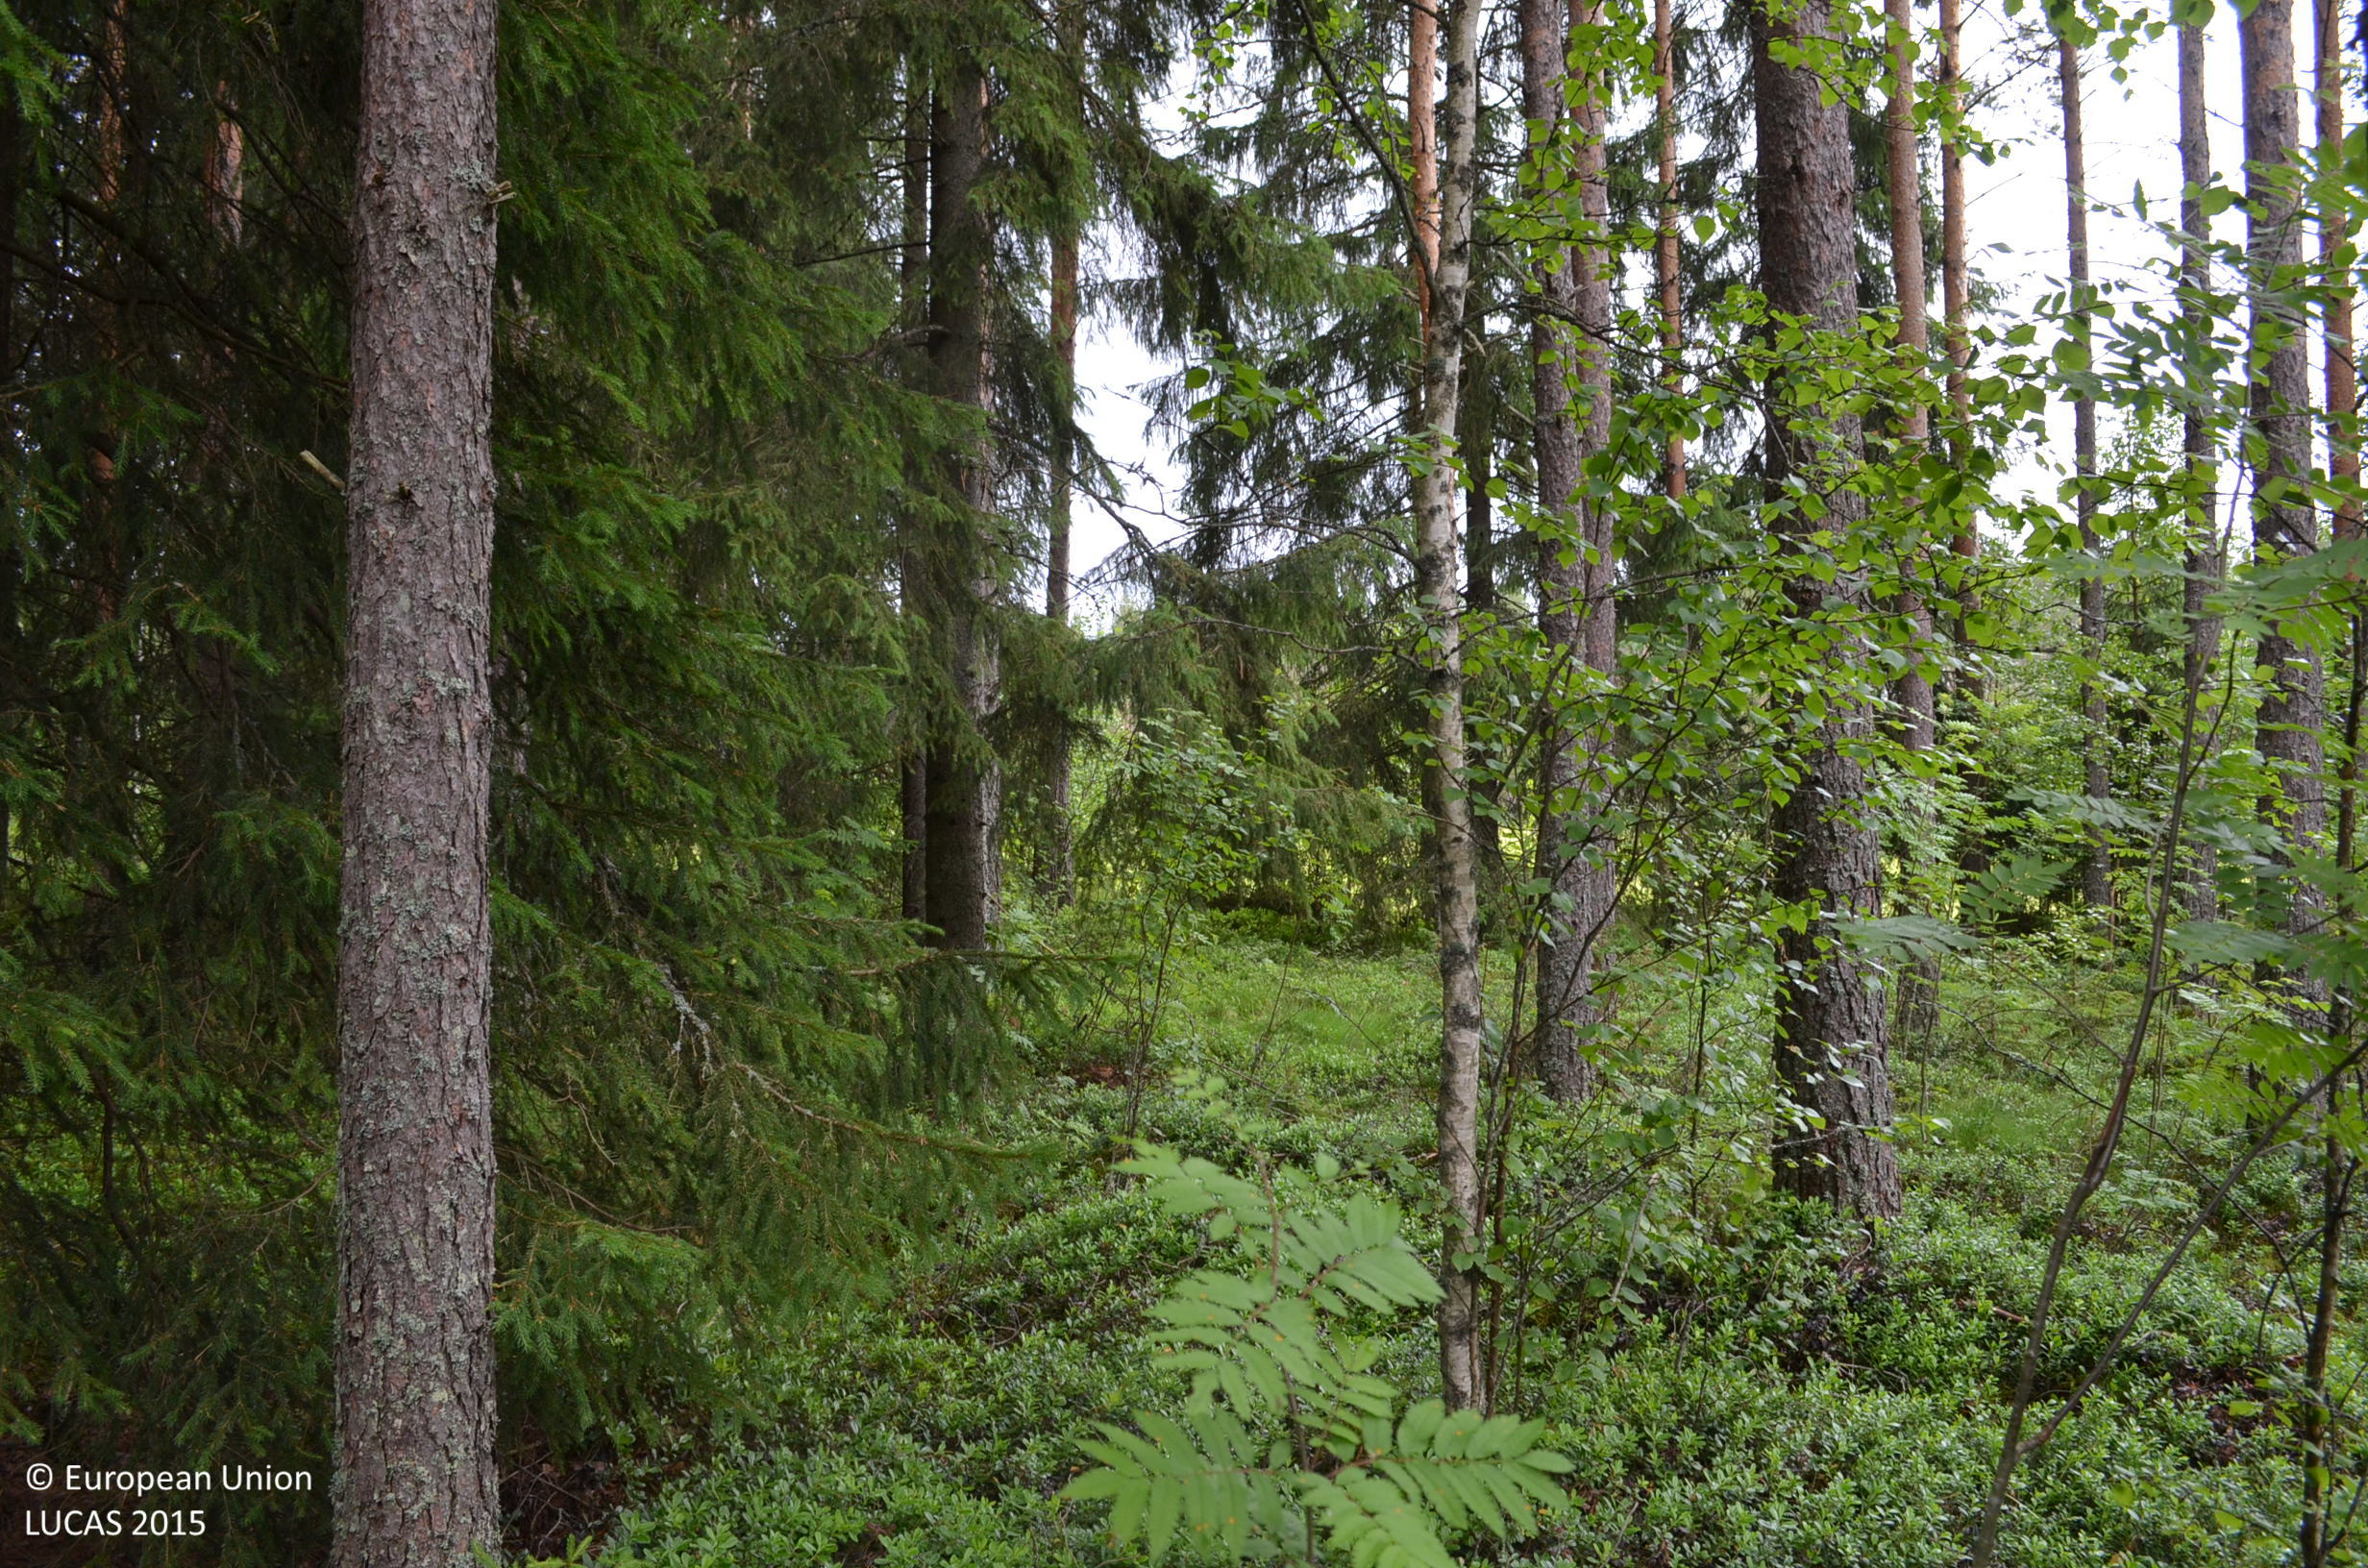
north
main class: Woodland
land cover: Pine dominated coniferous woodland
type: boreal forest
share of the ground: > 75 %
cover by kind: coniferous forest trees 80 %, broadleaved forest trees 10 %, shrubs 10 %
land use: Forestry
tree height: > 5 m
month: July
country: FI
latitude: 62.2863
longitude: 23.5861
